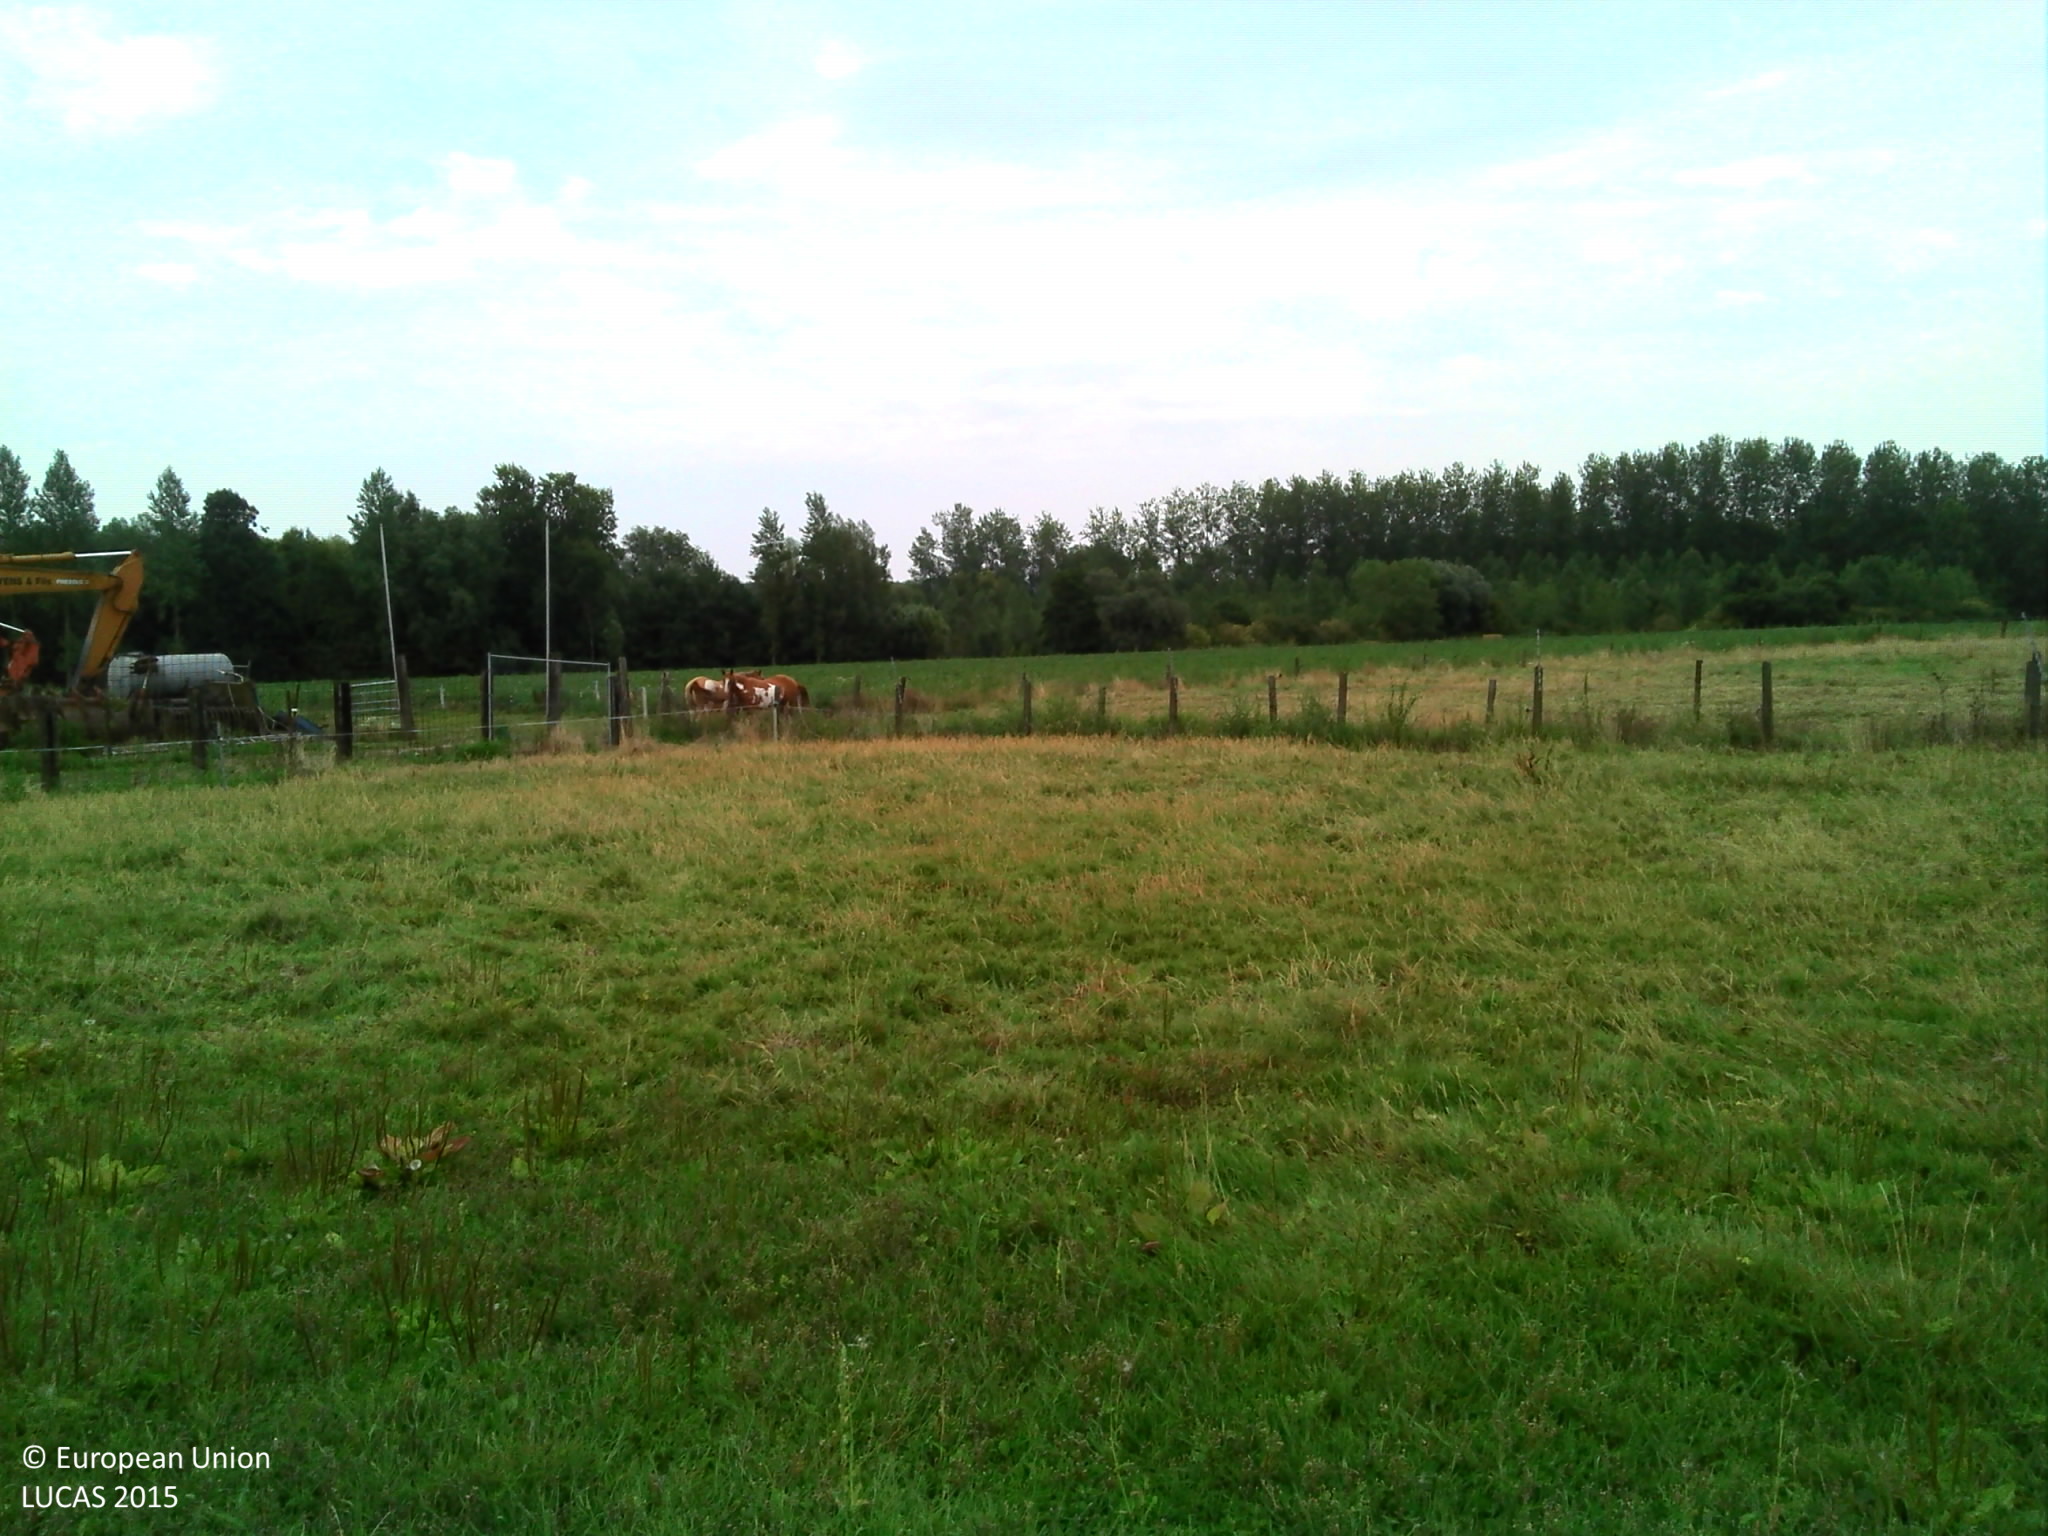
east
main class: Grassland
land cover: Grassland without tree/shrub cover
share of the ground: > 75 %
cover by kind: herbaceous plants 100 %
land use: Agriculture (excluding fallow land and kitchen gardens)
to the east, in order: Grassland without tree/shrub cover; Fences; Grass margins; Fences; Grassland without tree/shrub cover; Fences; Potatoes; Fences; Grassland without tree/shrub cover; Fences; Grassland without tree/shrub cover
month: August
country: BE
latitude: 50.6863
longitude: 3.8649
